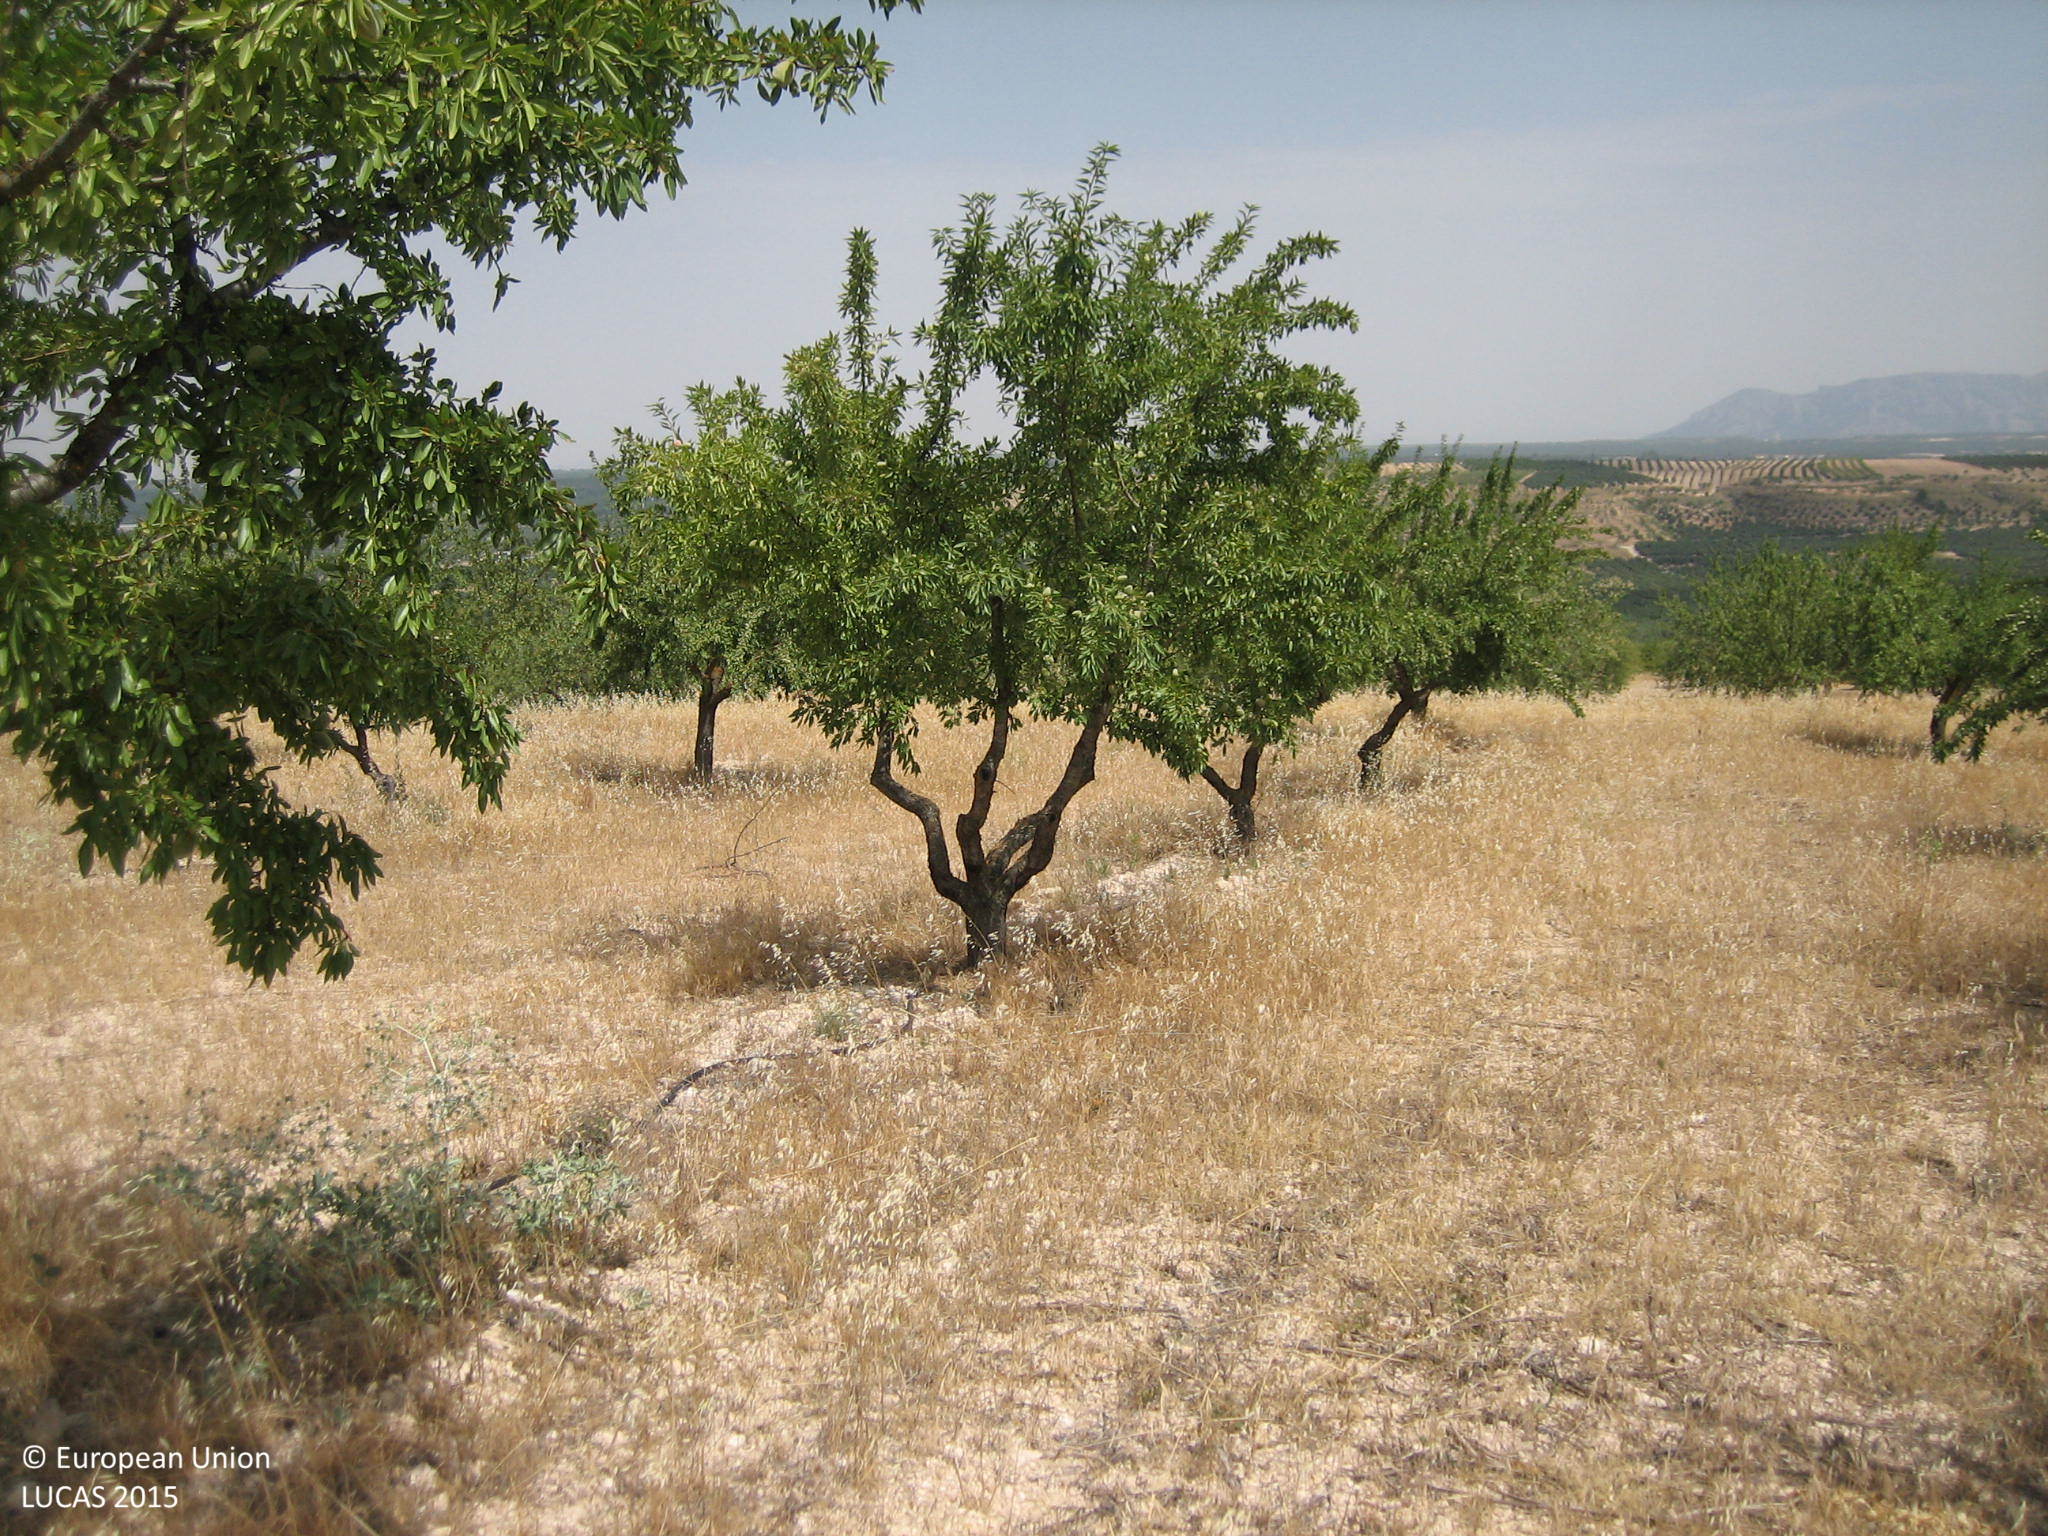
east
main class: Cropland
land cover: Nuts trees
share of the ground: 10 - 25 %
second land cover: Spontaneously vegetated surfaces
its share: > 75 %
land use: Agriculture (excluding fallow land and kitchen gardens)
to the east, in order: Nuts trees; Spontaneously vegetated surfaces; Grass margins; Nuts trees; Grass margins; Nuts trees
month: July
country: ES
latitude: 37.6769
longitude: -2.9967
